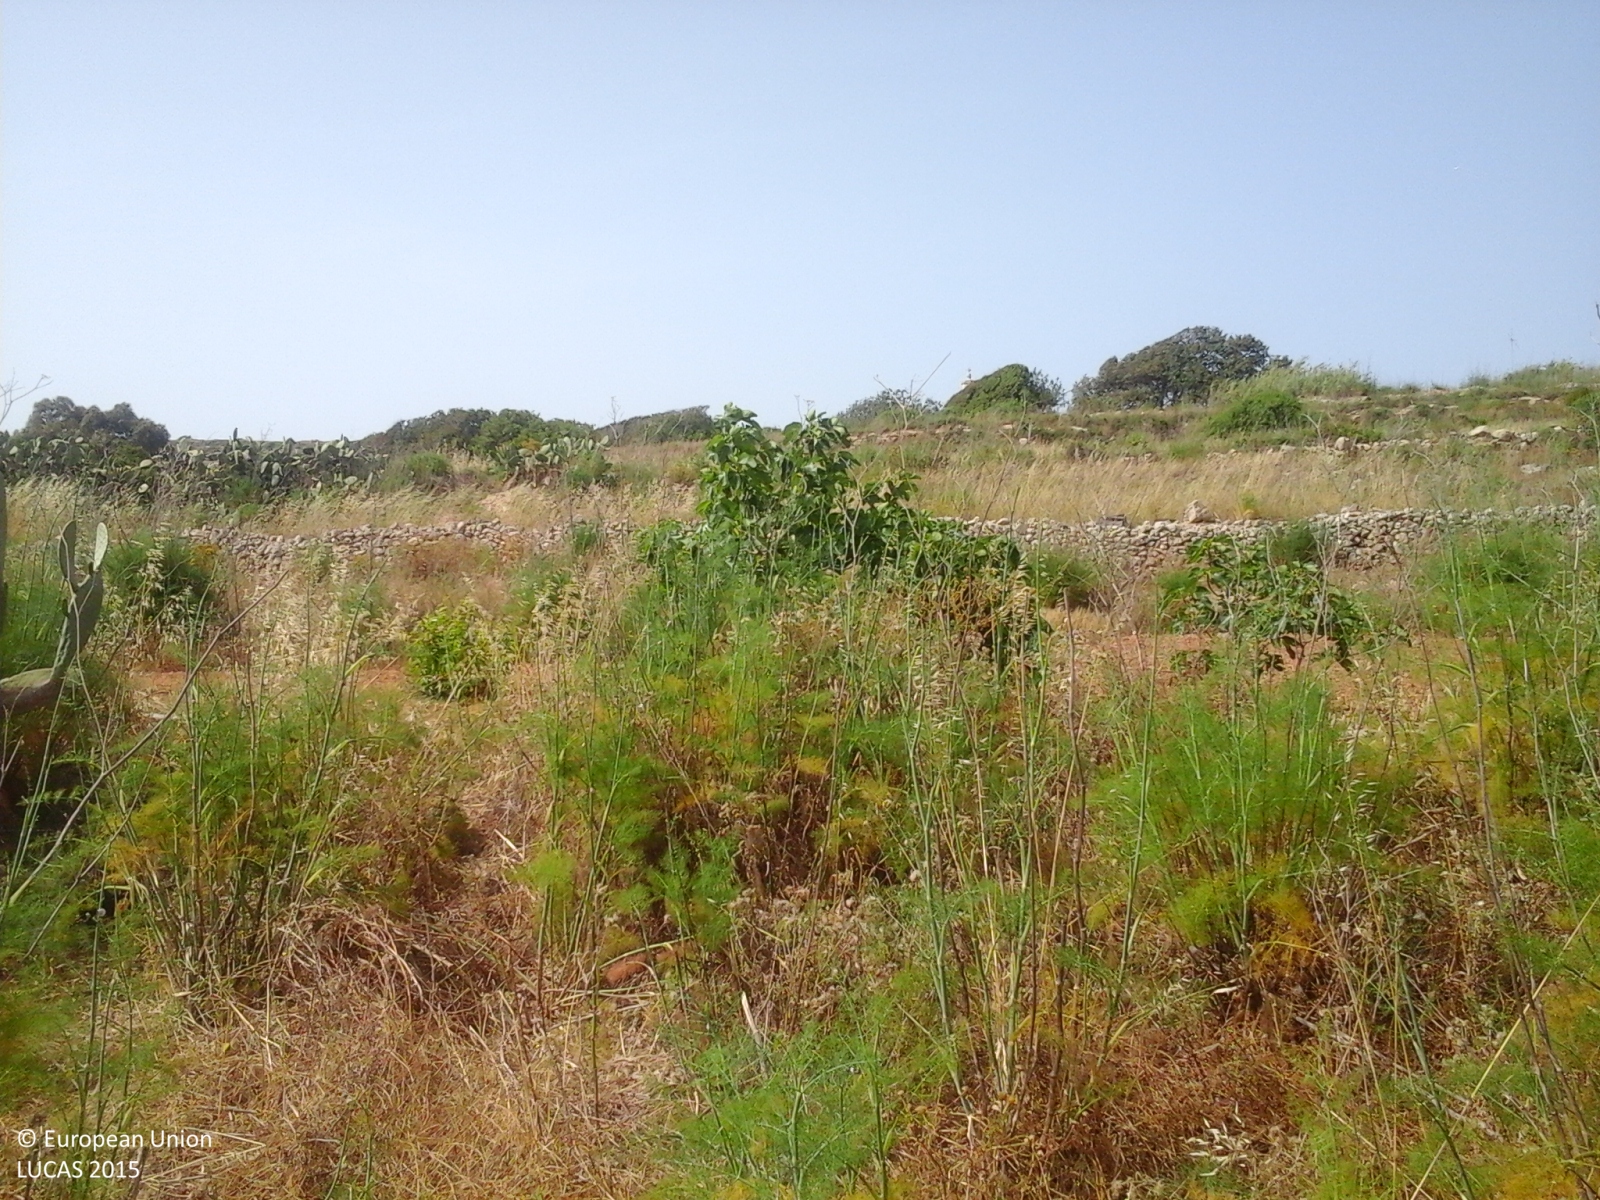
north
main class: Grassland
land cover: Spontaneously vegetated surfaces
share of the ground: 25 - 50 %
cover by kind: herbaceous plants 50 %, unconsolidated bare surface 30 %
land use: Agriculture (excluding fallow land and kitchen gardens)
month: May
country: MT
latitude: 35.9189
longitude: 14.3593
